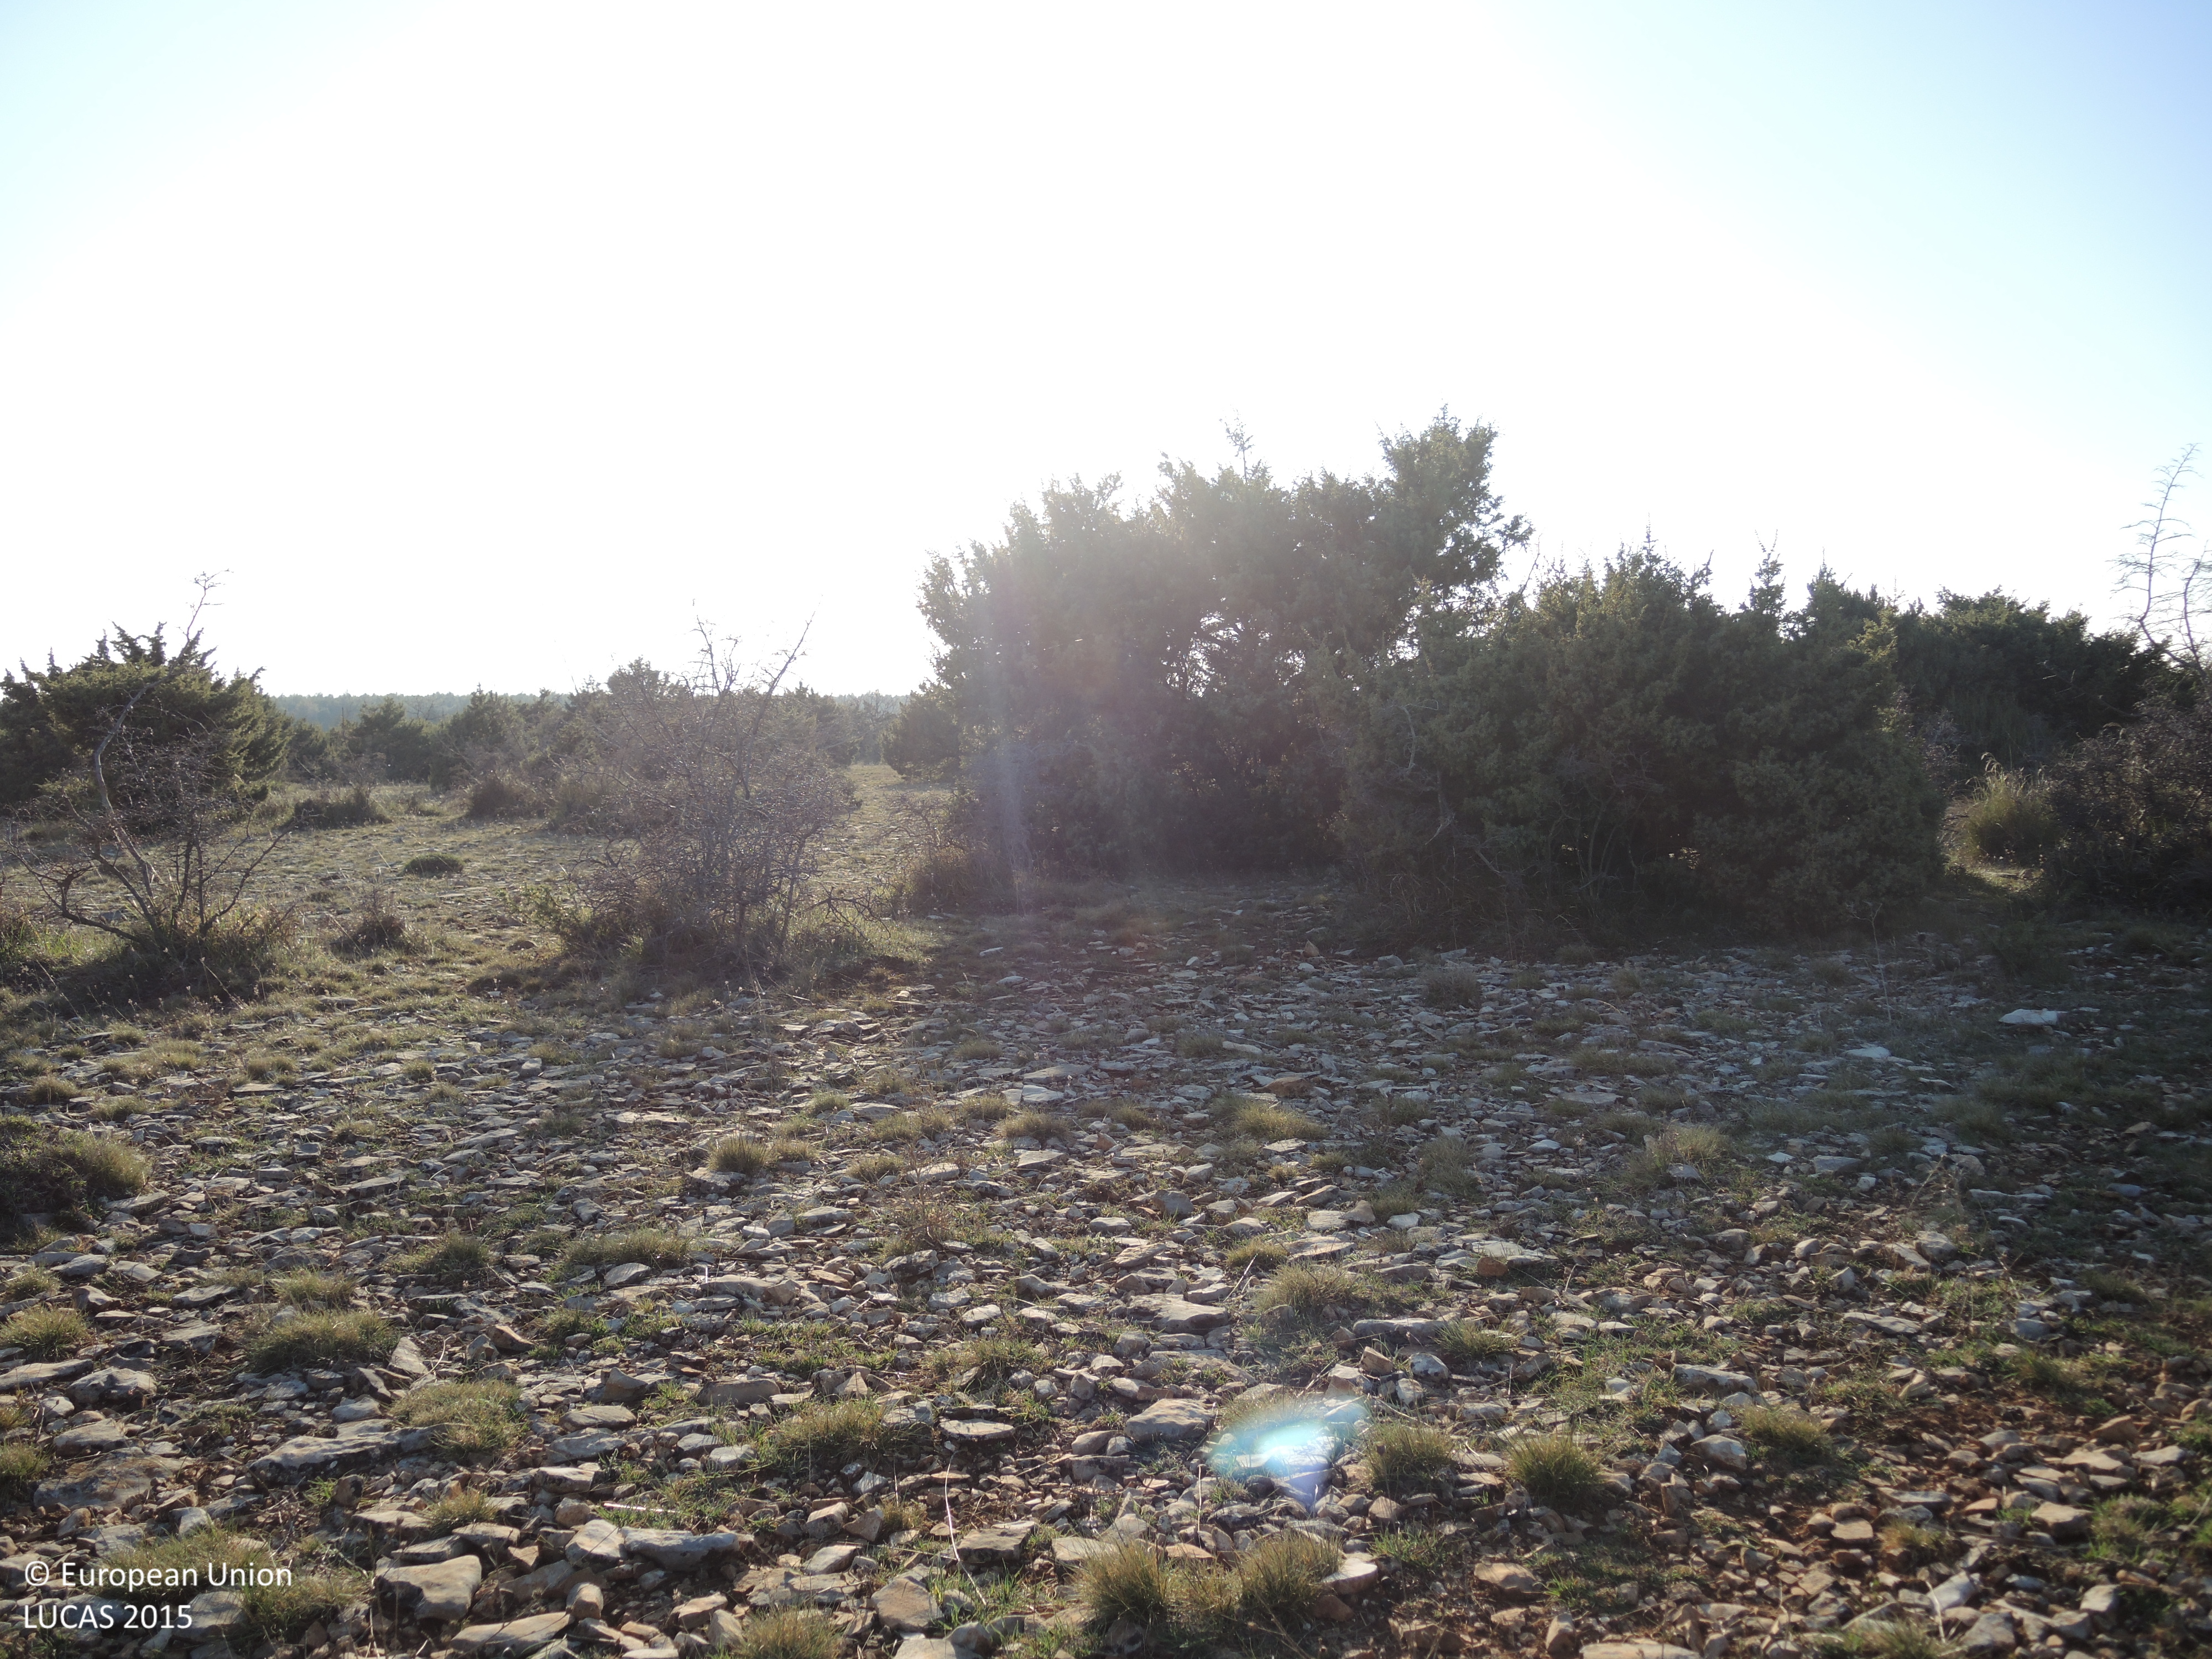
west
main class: Shrubland
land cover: Shrubland with sparse tree cover
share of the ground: 10 - 25 %
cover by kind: unconsolidated bare surface 40 %, shrubs 25 %, herbaceous plants 25 %, broadleaved forest trees 5 %, consolidated bare surface 5 %
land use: Semi-natural and natural areas not in use
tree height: < 5 m
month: April
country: HR
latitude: 44.0536
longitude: 15.6214
